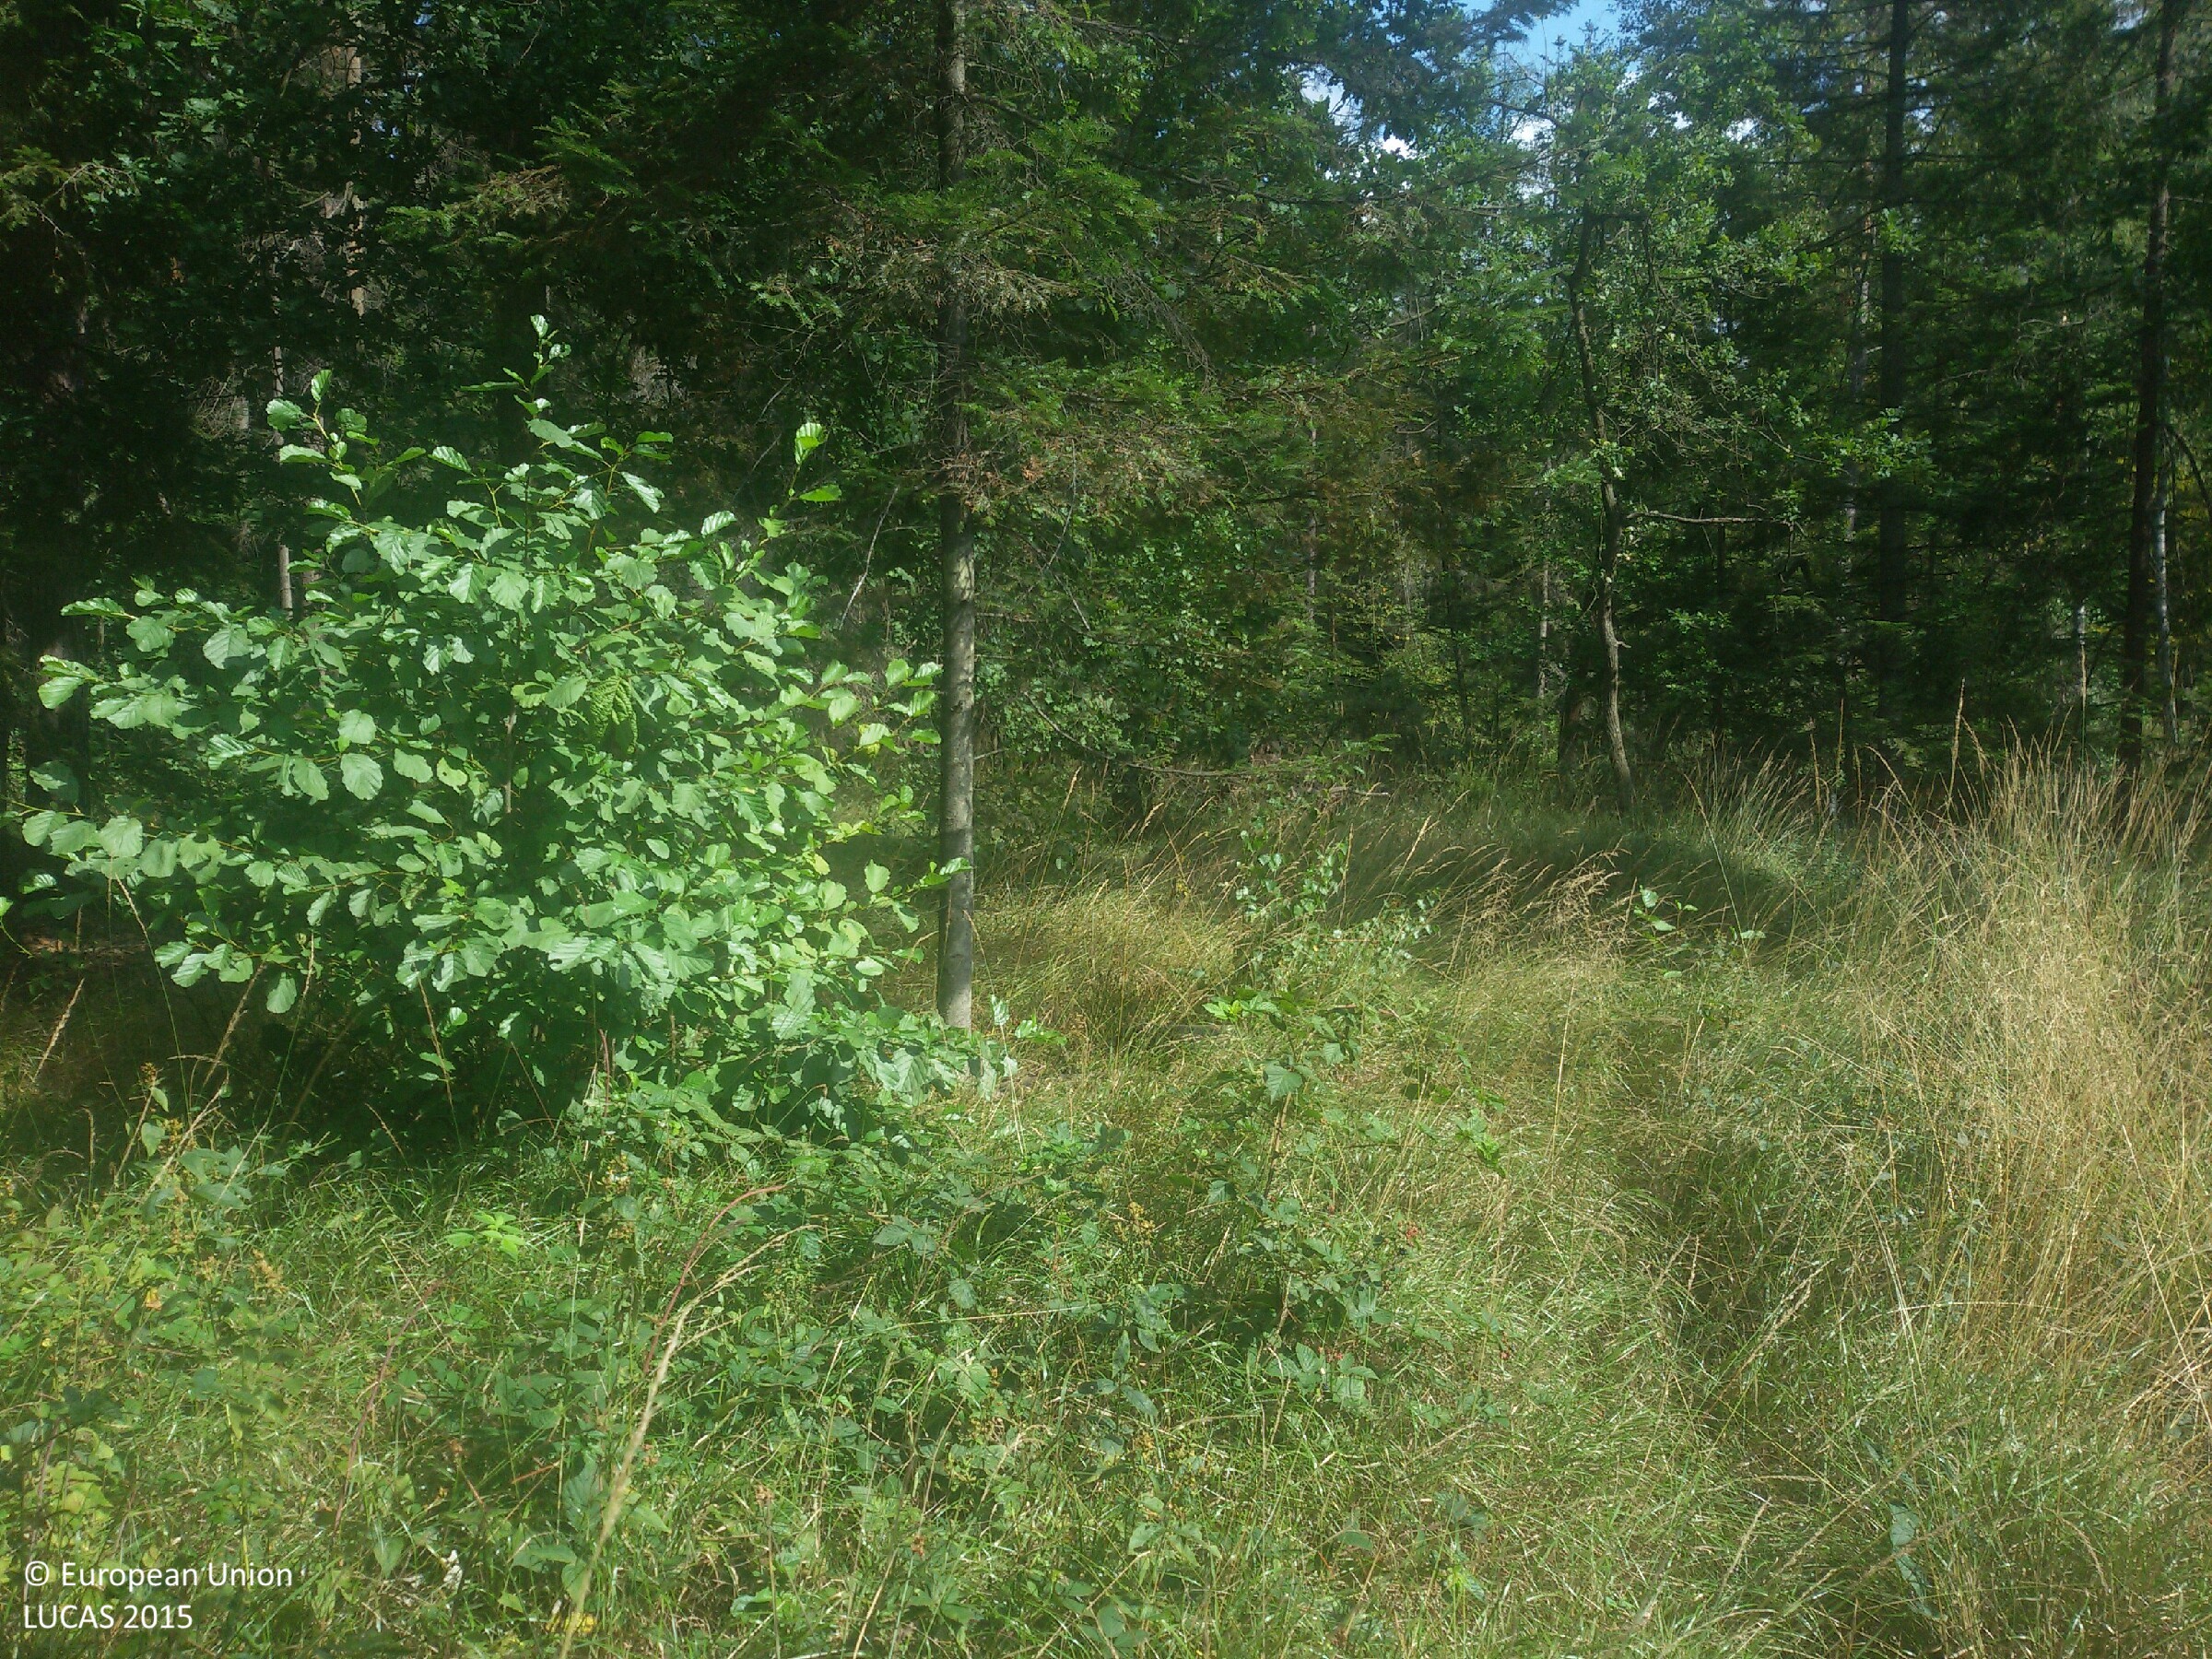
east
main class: Woodland
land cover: Pine dominated mixed woodland
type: hemiboreal forest and nemoral coniferous forest and mixed broadleaved-coniferous forest
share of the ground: > 75 %
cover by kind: coniferous forest trees 60 %, broadleaved forest trees 25 %, herbaceous plants 10 %, shrubs 5 %
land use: Forestry
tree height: > 5 m
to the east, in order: Pine dominated mixed woodland; Other coniferous woodland; Rivers and streams; Other coniferous woodland; Paved roads, cycling and walking lanes; Pine dominated mixed woodland
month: September
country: PL
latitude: 50.9987
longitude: 20.9444
